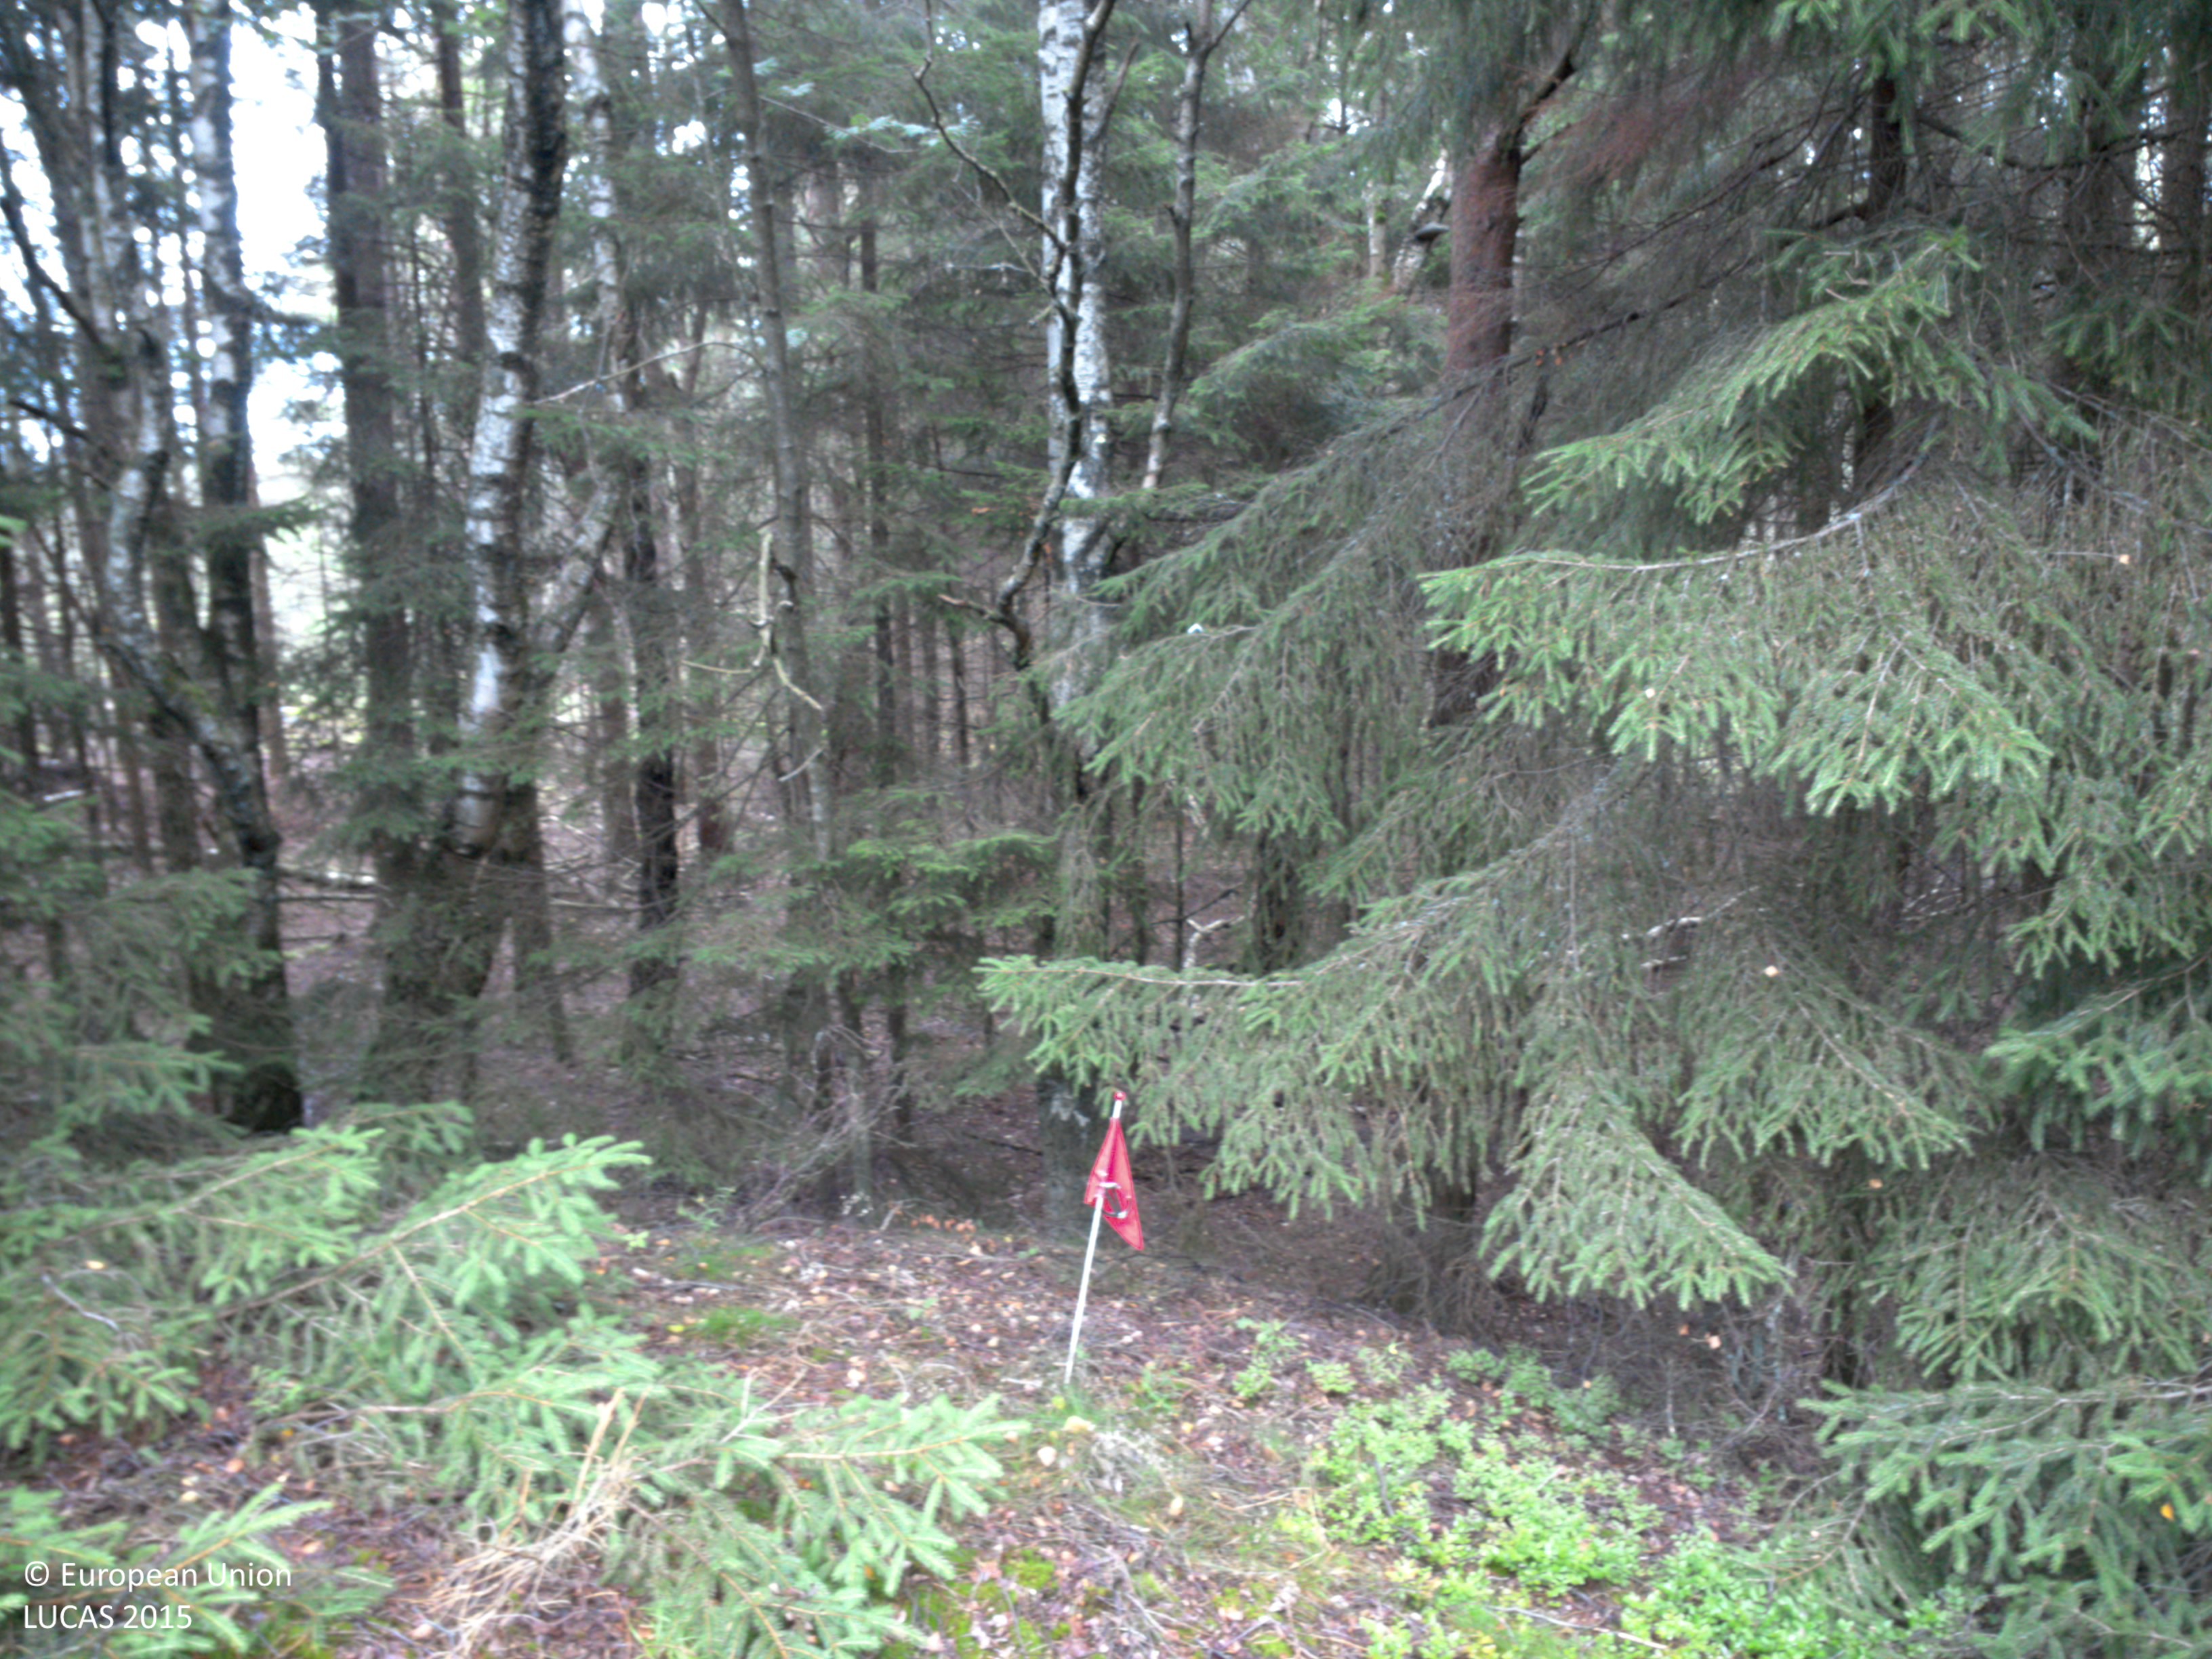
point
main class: Woodland
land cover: Spruce dominated mixed woodland
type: boreal forest
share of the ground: 50 - 75 %
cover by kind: coniferous forest trees 50 %, broadleaved forest trees 20 %, lichens and mosses 20 %, herbaceous plants 10 %
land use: Forestry
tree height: > 5 m
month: July
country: SE
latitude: 58.0116
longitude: 11.6386
